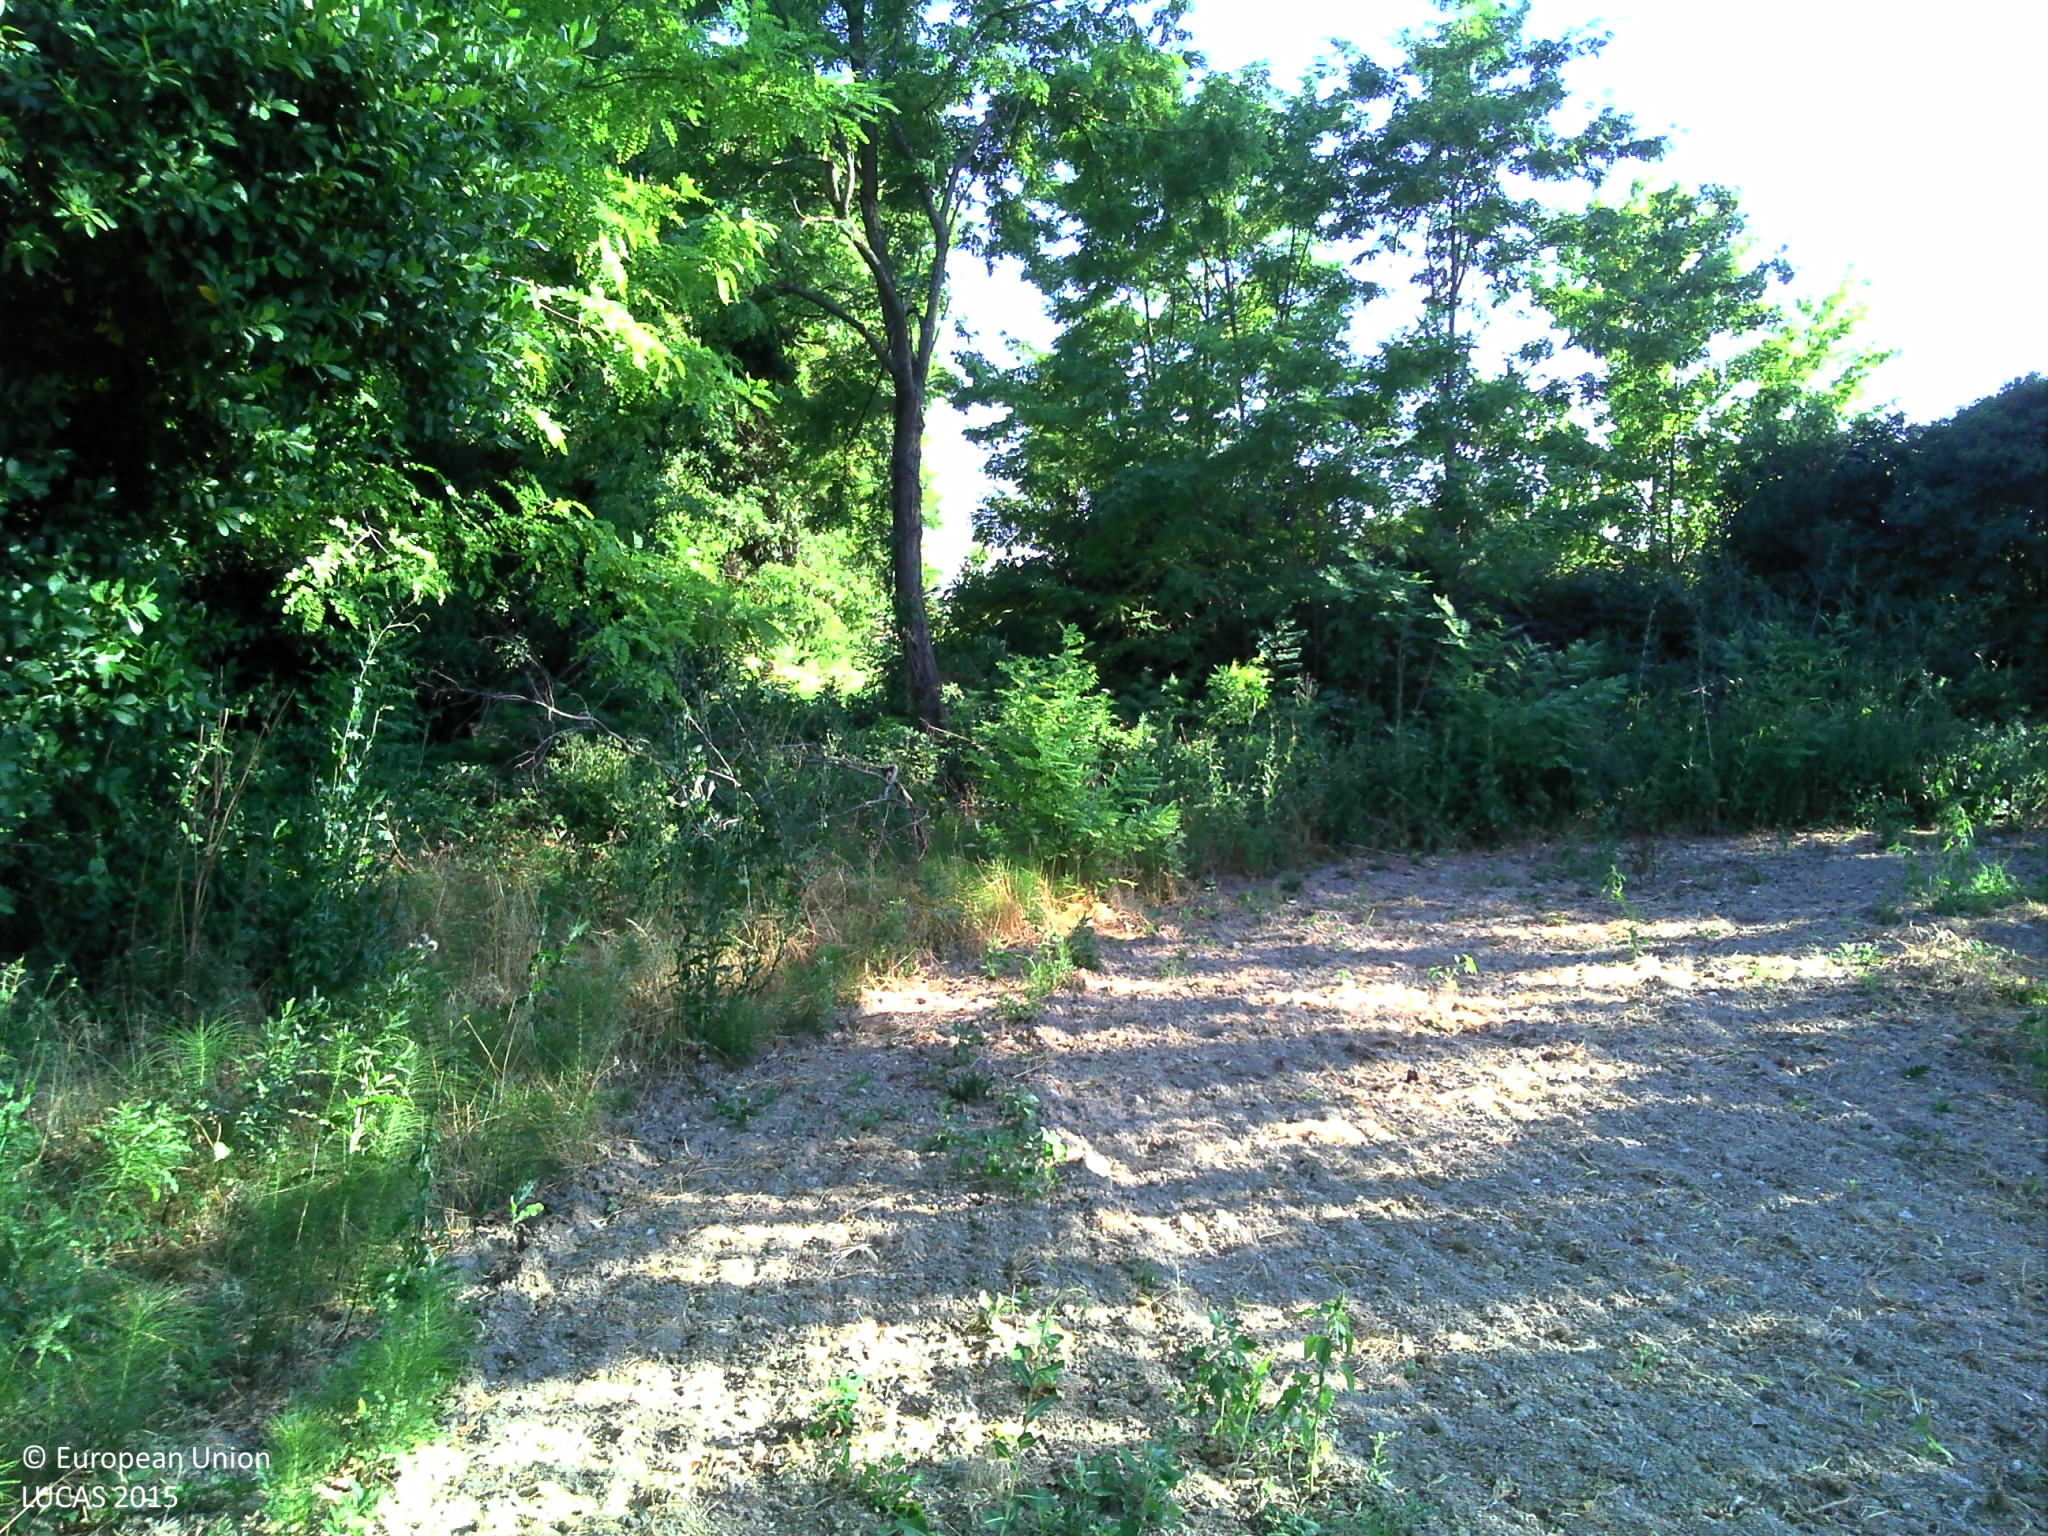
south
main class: Woodland
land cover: Broadleaved woodland
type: mesophytic deciduous forest
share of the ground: > 75 %
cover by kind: broadleaved forest trees 70 %, shrubs 20 %, herbaceous plants 10 %
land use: Forestry
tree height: > 5 m
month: July
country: FR
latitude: 44.1501
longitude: 4.8444
